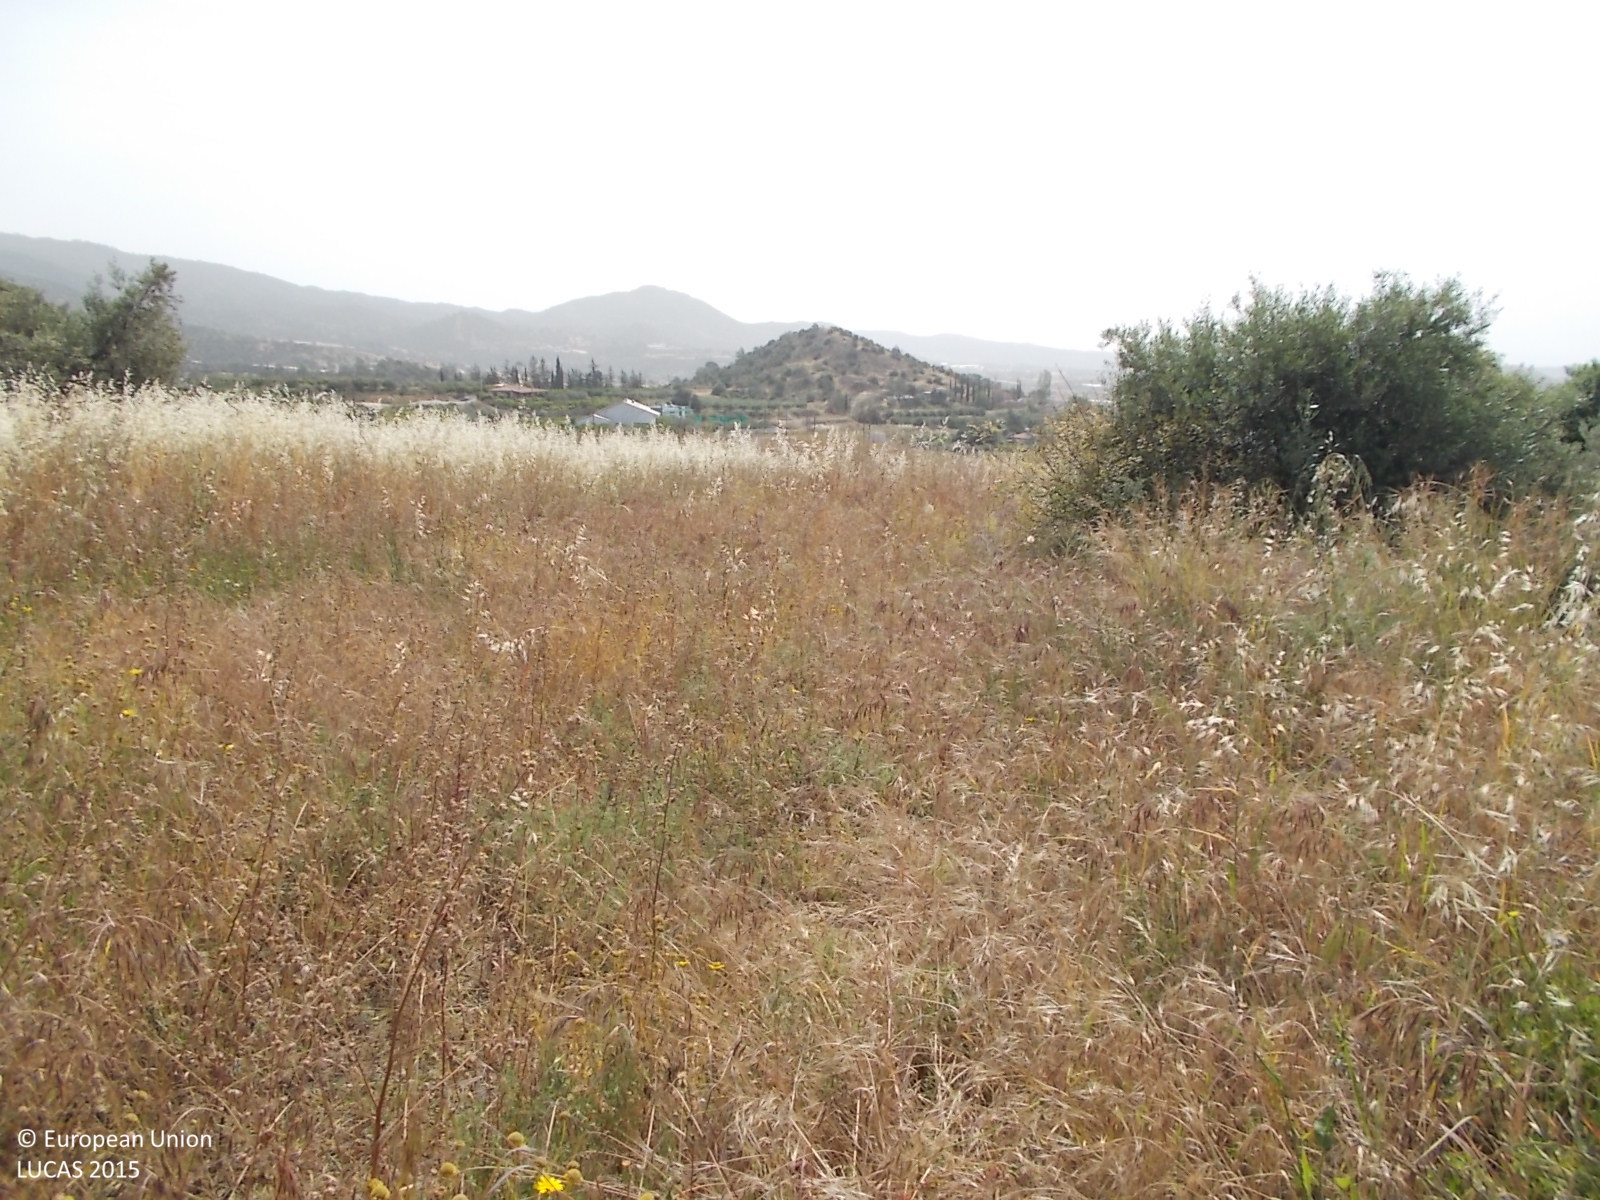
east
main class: Grassland
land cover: Spontaneously vegetated surfaces
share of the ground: > 75 %
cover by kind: herbaceous plants 100 %
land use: Fallow land
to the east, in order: Spontaneously vegetated surfaces; Shrubland without tree cover; Spontaneously vegetated surfaces; Abandoned hedges; Tracks; Other citrus fruit; Other fruit trees and berries; Shrubland without tree cover; Nuts trees; Other citrus fruit; Other fruit trees and berries; Tracks; Spontaneously vegetated surfaces; Grass margins; Other fruit trees and berries; Other bare soil; Tracks; Grass margins; Other bare soil
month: April
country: CY
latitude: 34.7739
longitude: 33.1512
